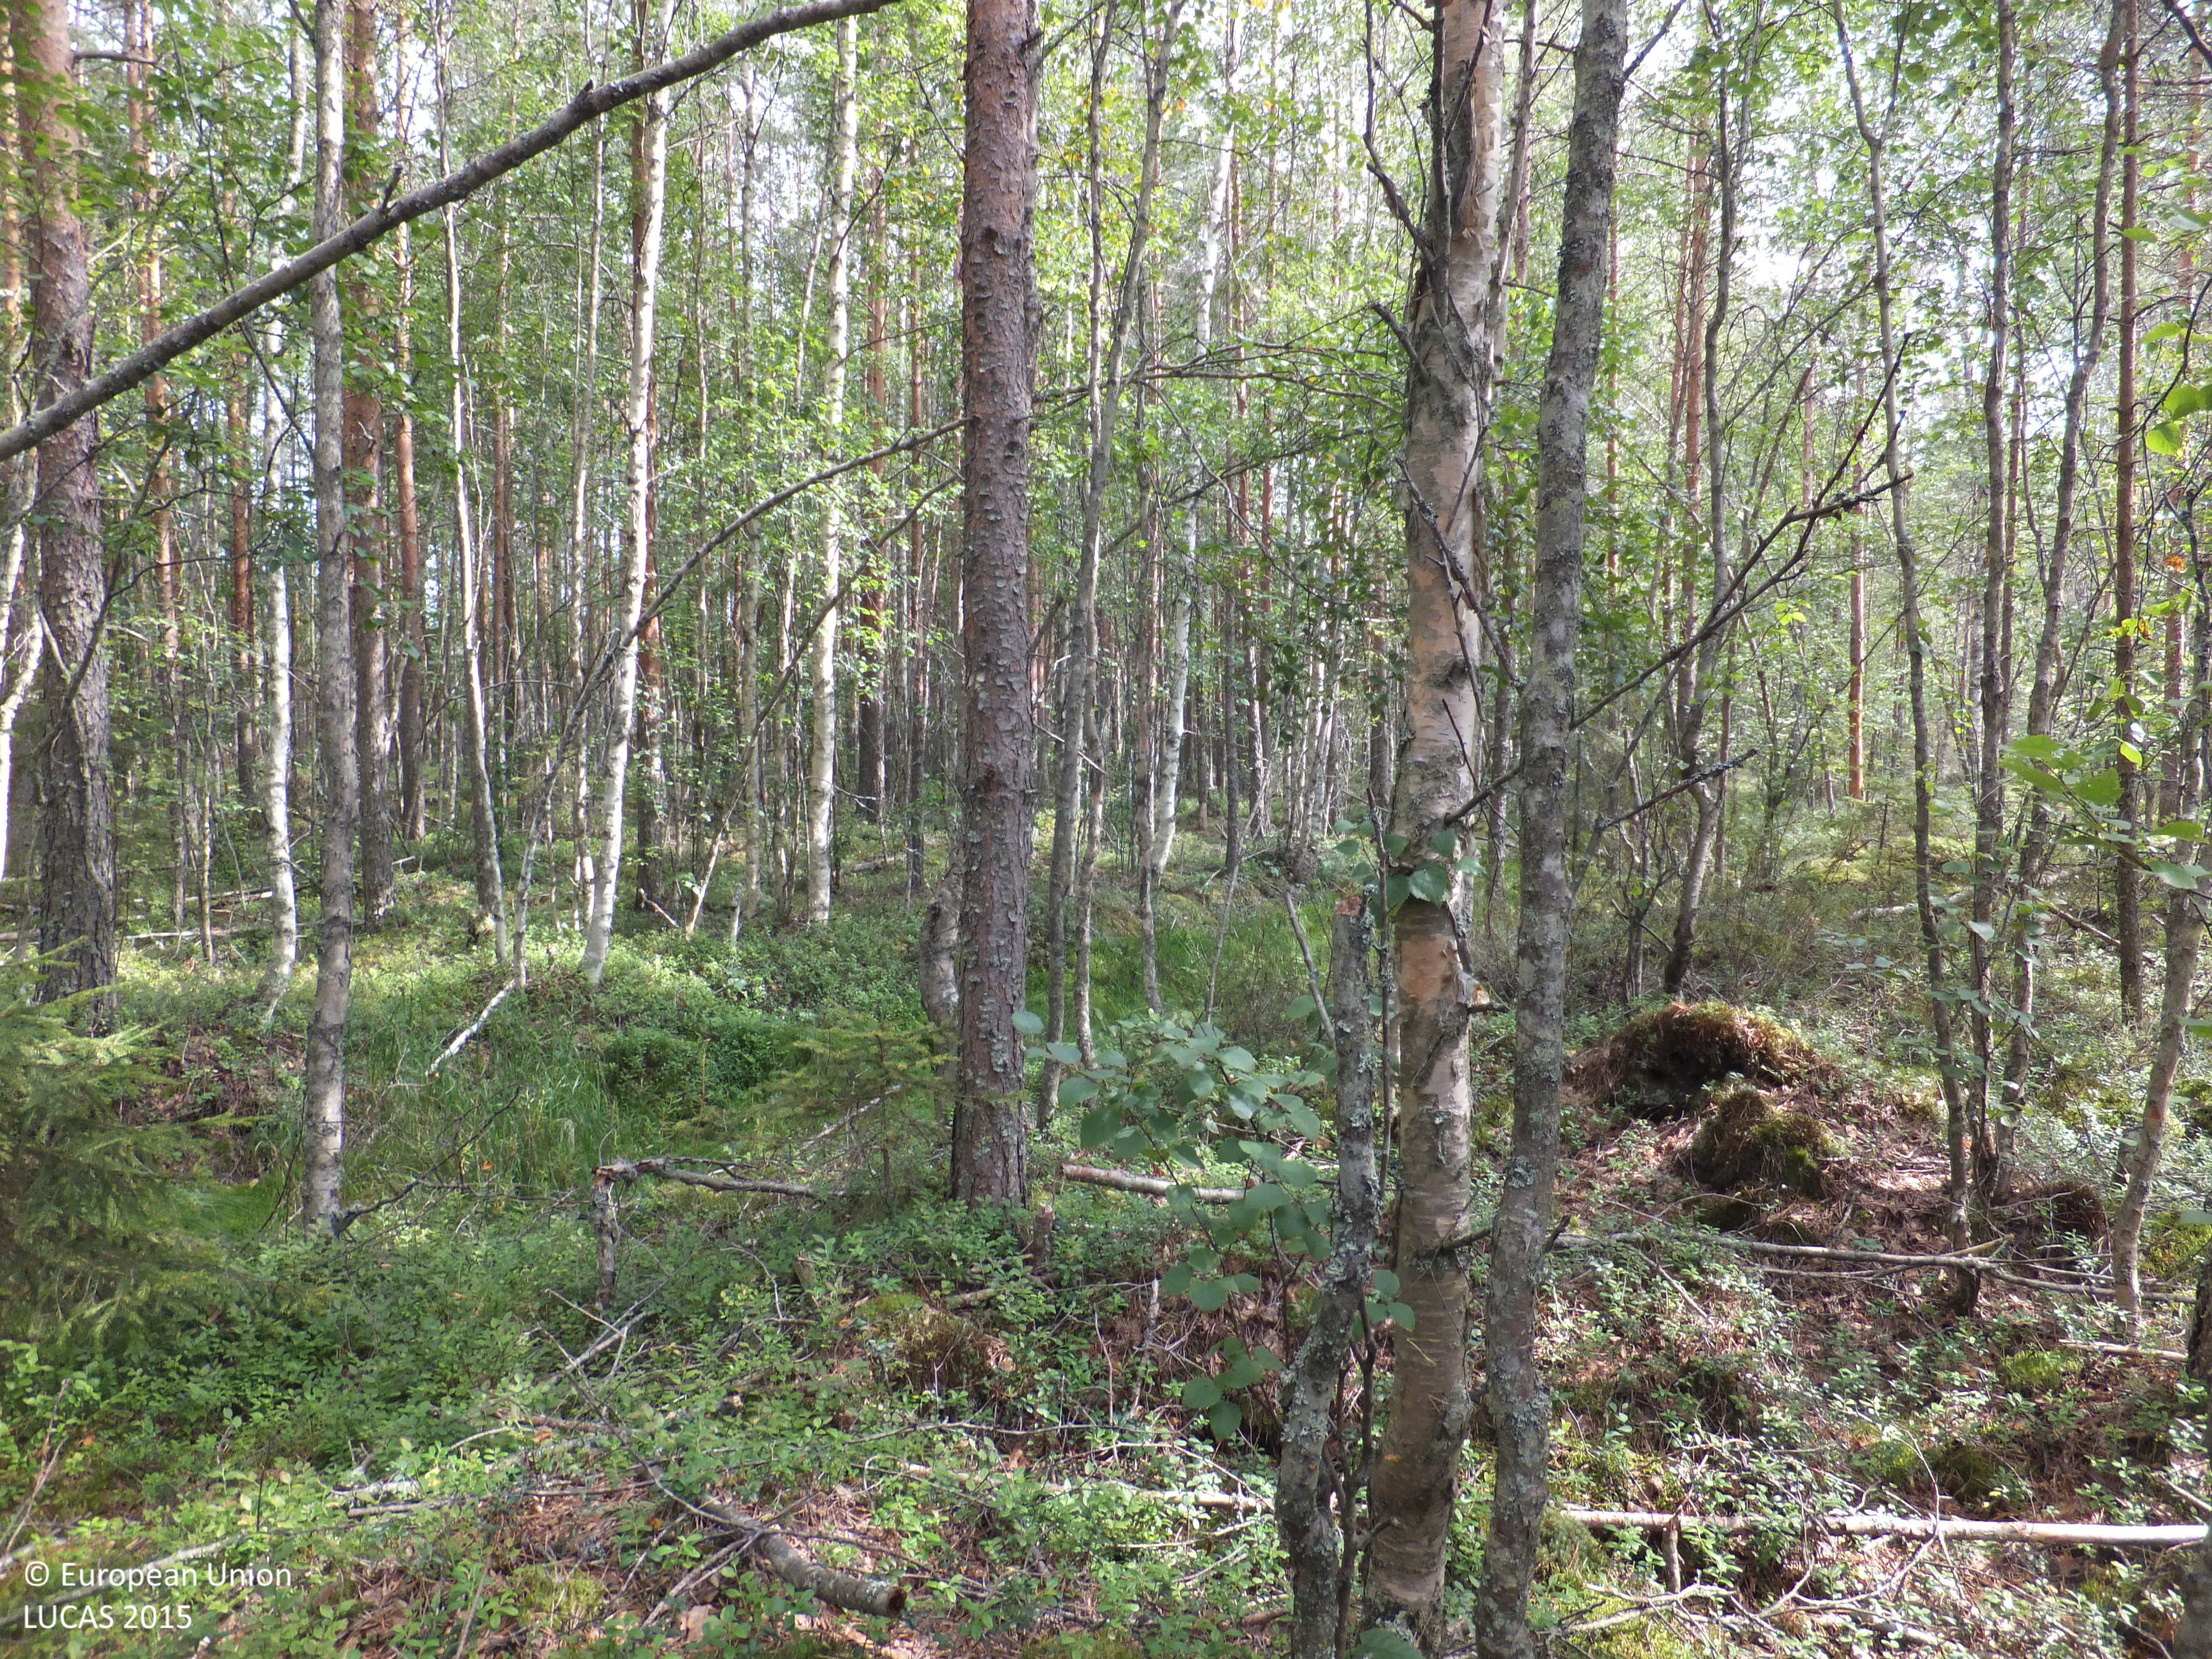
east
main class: Woodland
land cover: Pine dominated mixed woodland
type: boreal forest
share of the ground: > 75 %
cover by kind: coniferous forest trees 40 %, broadleaved forest trees 40 %, shrubs 15 %, lichens and mosses 5 %
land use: Forestry
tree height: > 5 m
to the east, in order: Pine dominated mixed woodland; Ditches and canals; Pine dominated mixed woodland; Ditches and canals; Pine dominated mixed woodland; Ditches and canals; Pine dominated coniferous woodland; Ditches and canals; Pine dominated coniferous woodland; Ditches and canals; Pine dominated coniferous woodland
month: August
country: FI
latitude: 63.1672
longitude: 22.7423
